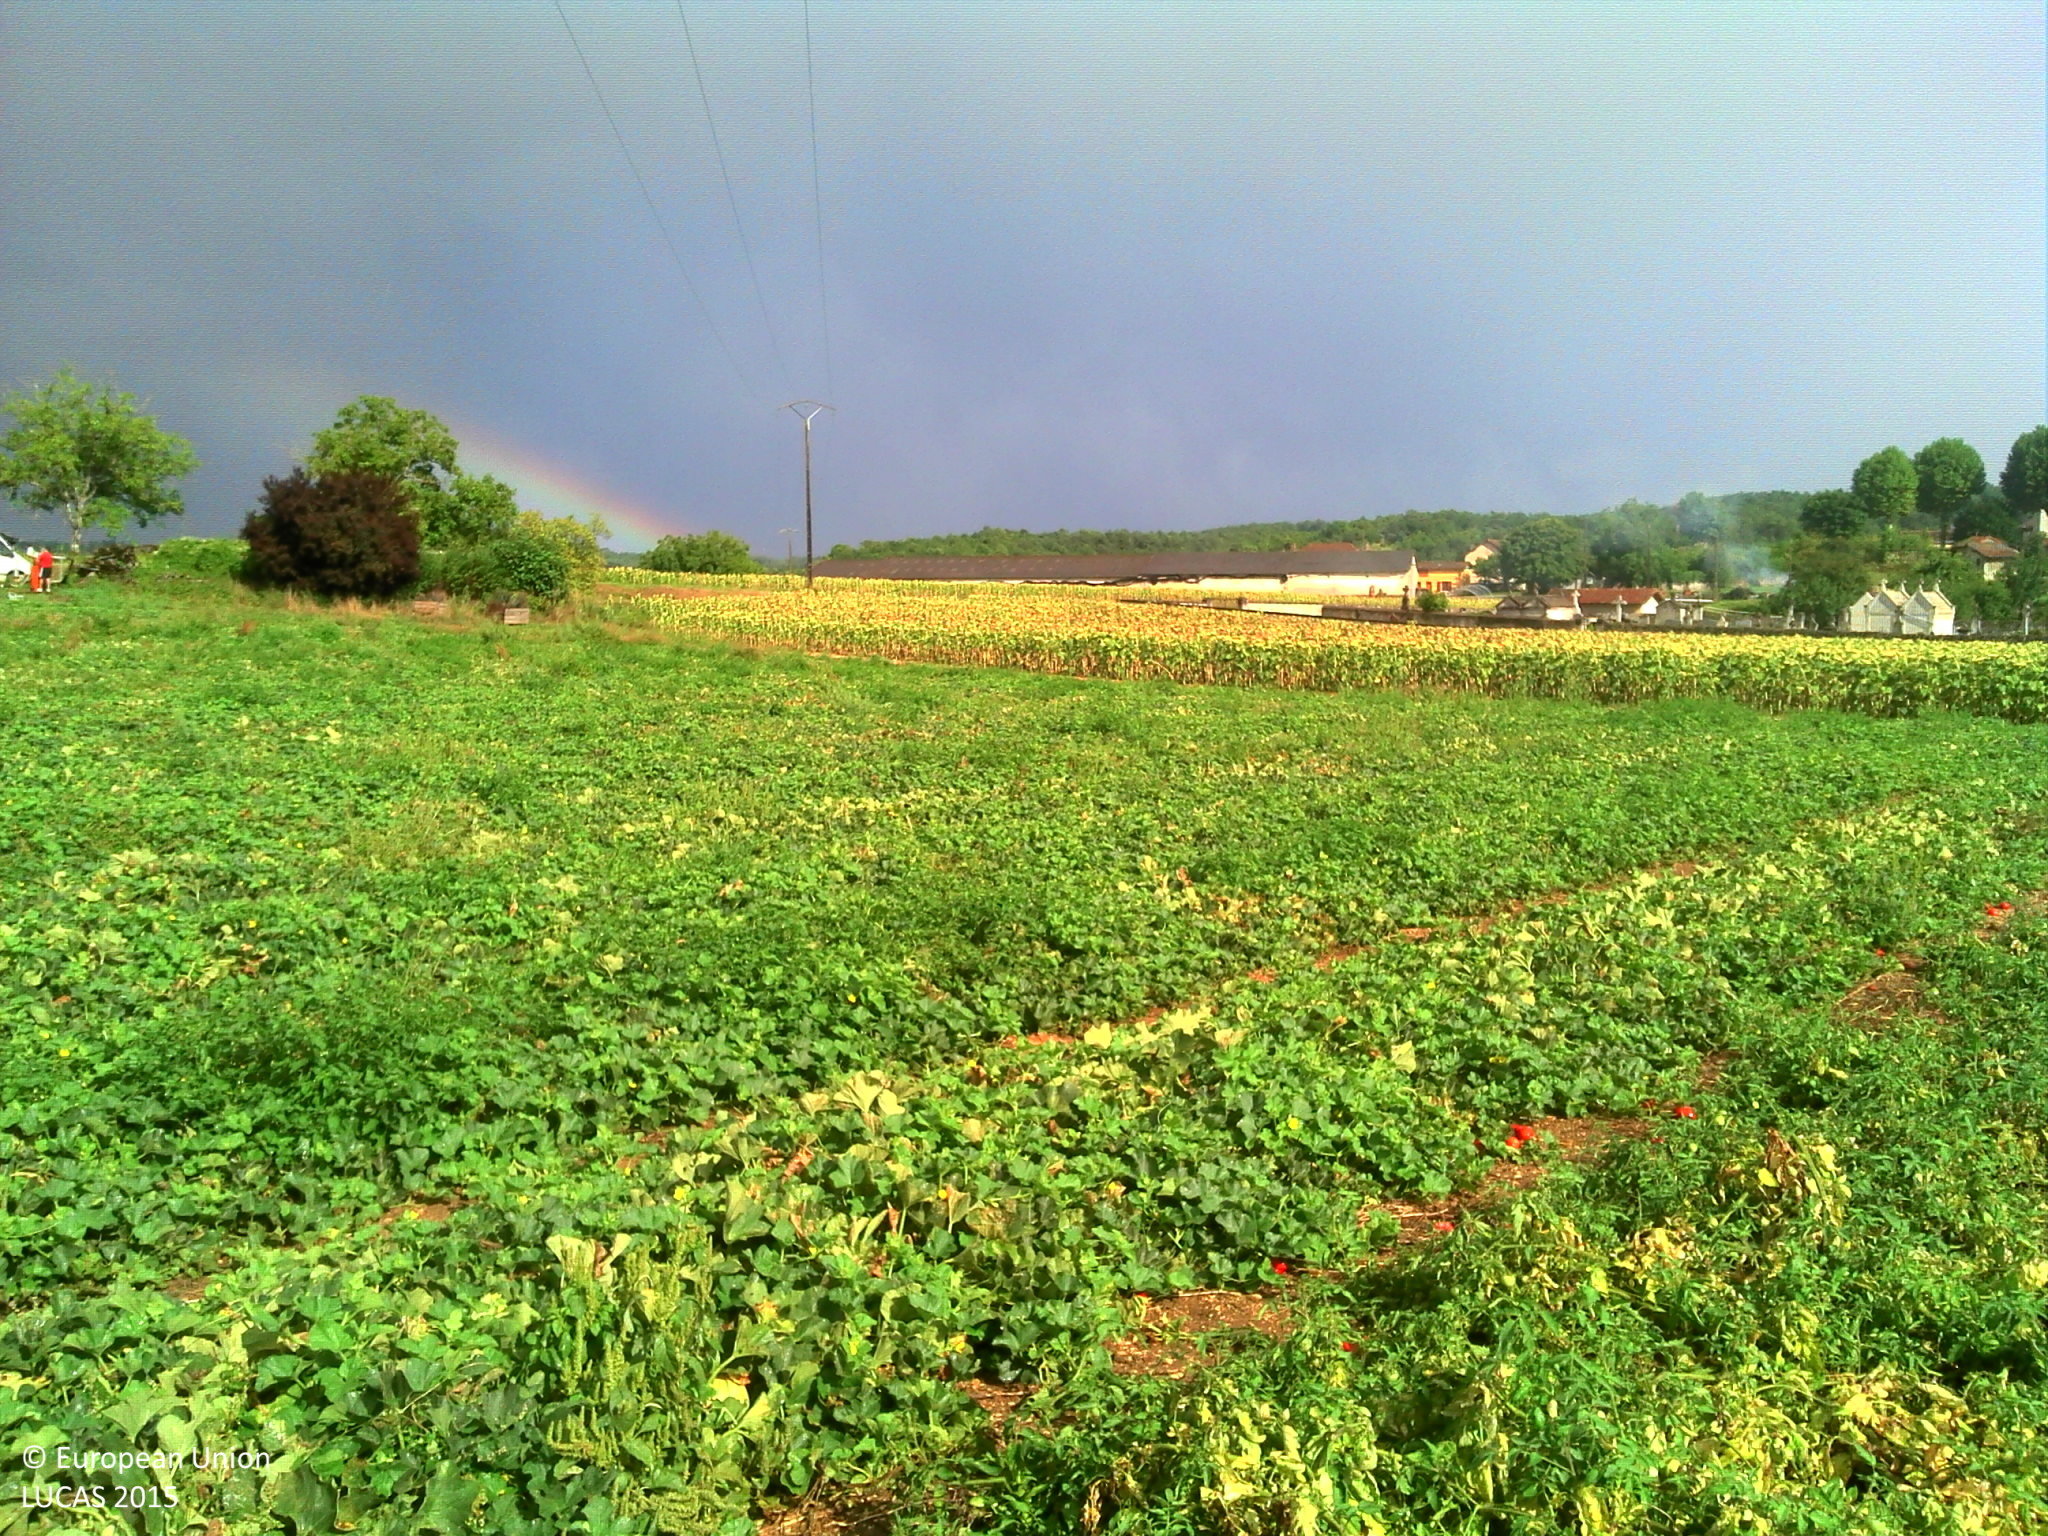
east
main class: Cropland
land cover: Other fresh vegetables
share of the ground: 25 - 50 %
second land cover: Tomatoes
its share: 10 - 25 %
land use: Agriculture (excluding fallow land and kitchen gardens)
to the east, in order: Other fresh vegetables; Tomatoes; Electric lines; Other fresh vegetables; Artificial constructions in urban areas; Managed hedges; Tracks; Grassland without tree/shrub cover; Lines of trees; Grassland without tree/shrub cover; Tracks; Sunflower; Ditches and canals; Grass margins; Paved roads, cycling and walking lanes; Grass margins; Spontaneously vegetated surfaces; Lucerne
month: August
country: FR
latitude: 45.3836
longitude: 0.7043
